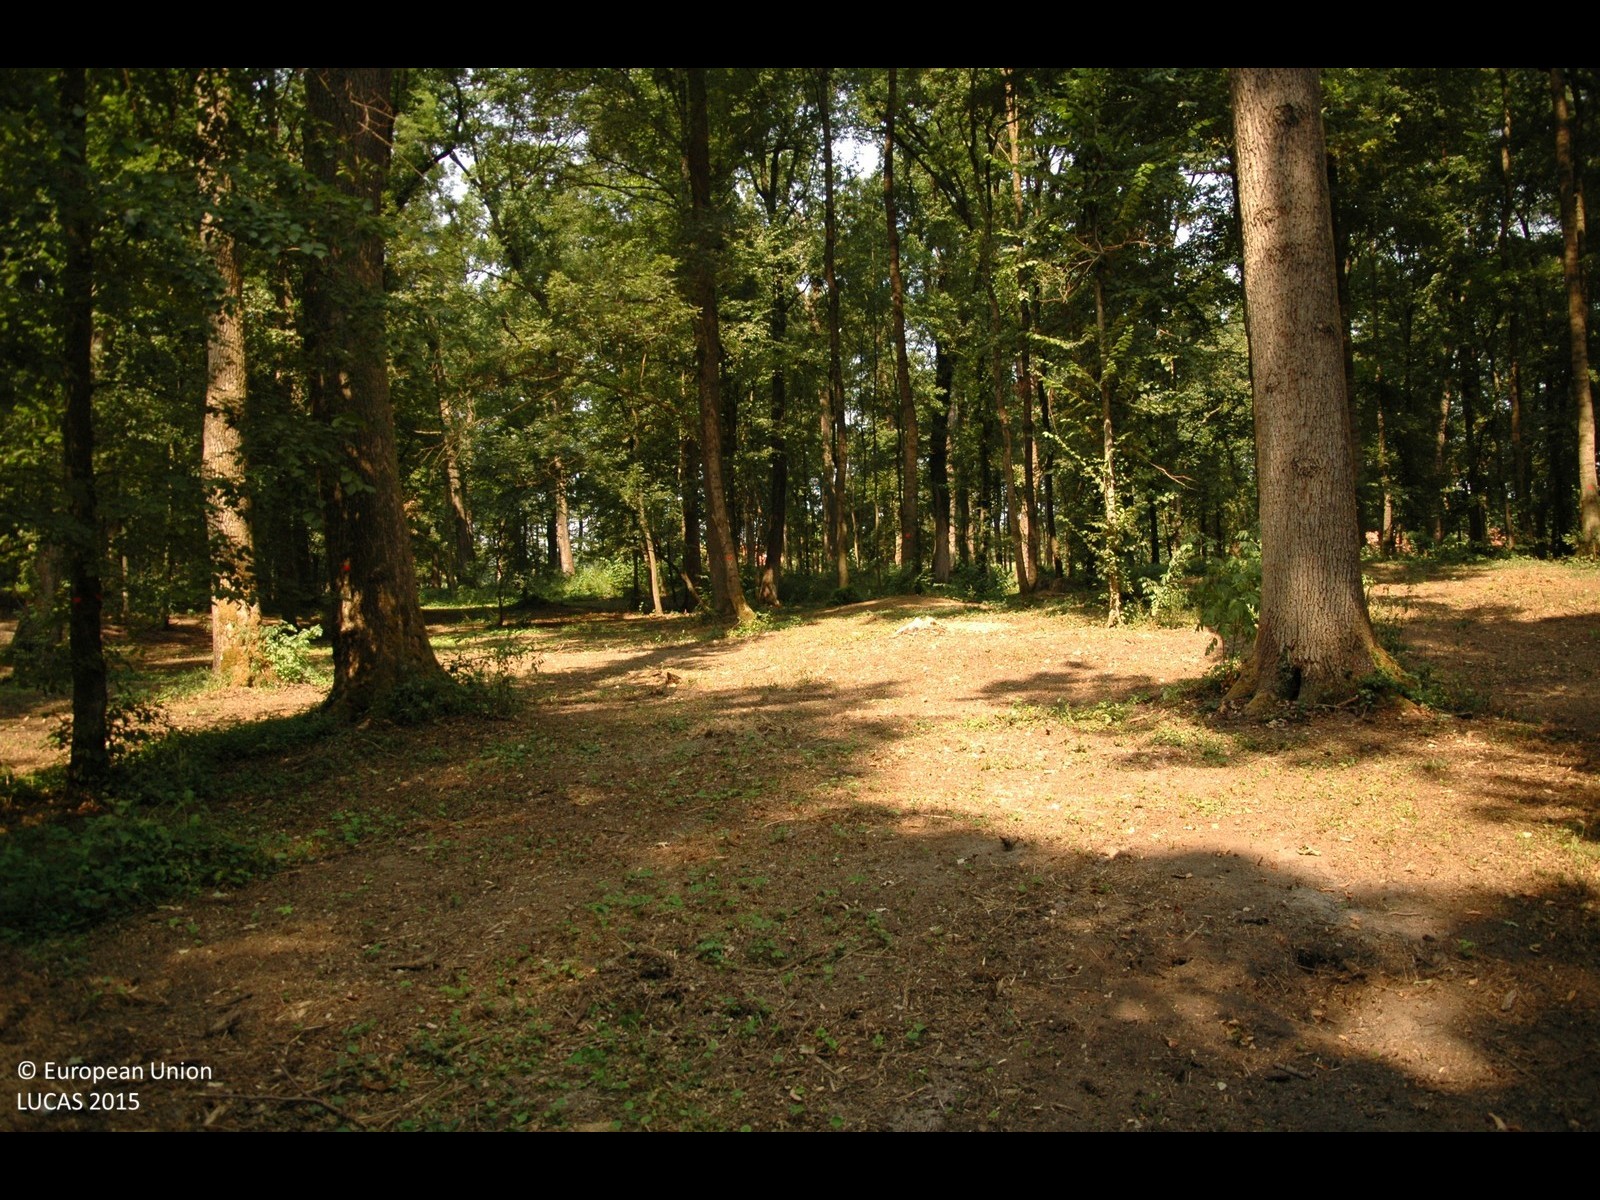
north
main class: Woodland
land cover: Broadleaved woodland
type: mesophytic deciduous forest
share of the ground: > 75 %
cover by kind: broadleaved forest trees 100 %
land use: Forestry
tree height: > 5 m
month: August
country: HR
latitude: 45.9968
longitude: 17.2457
